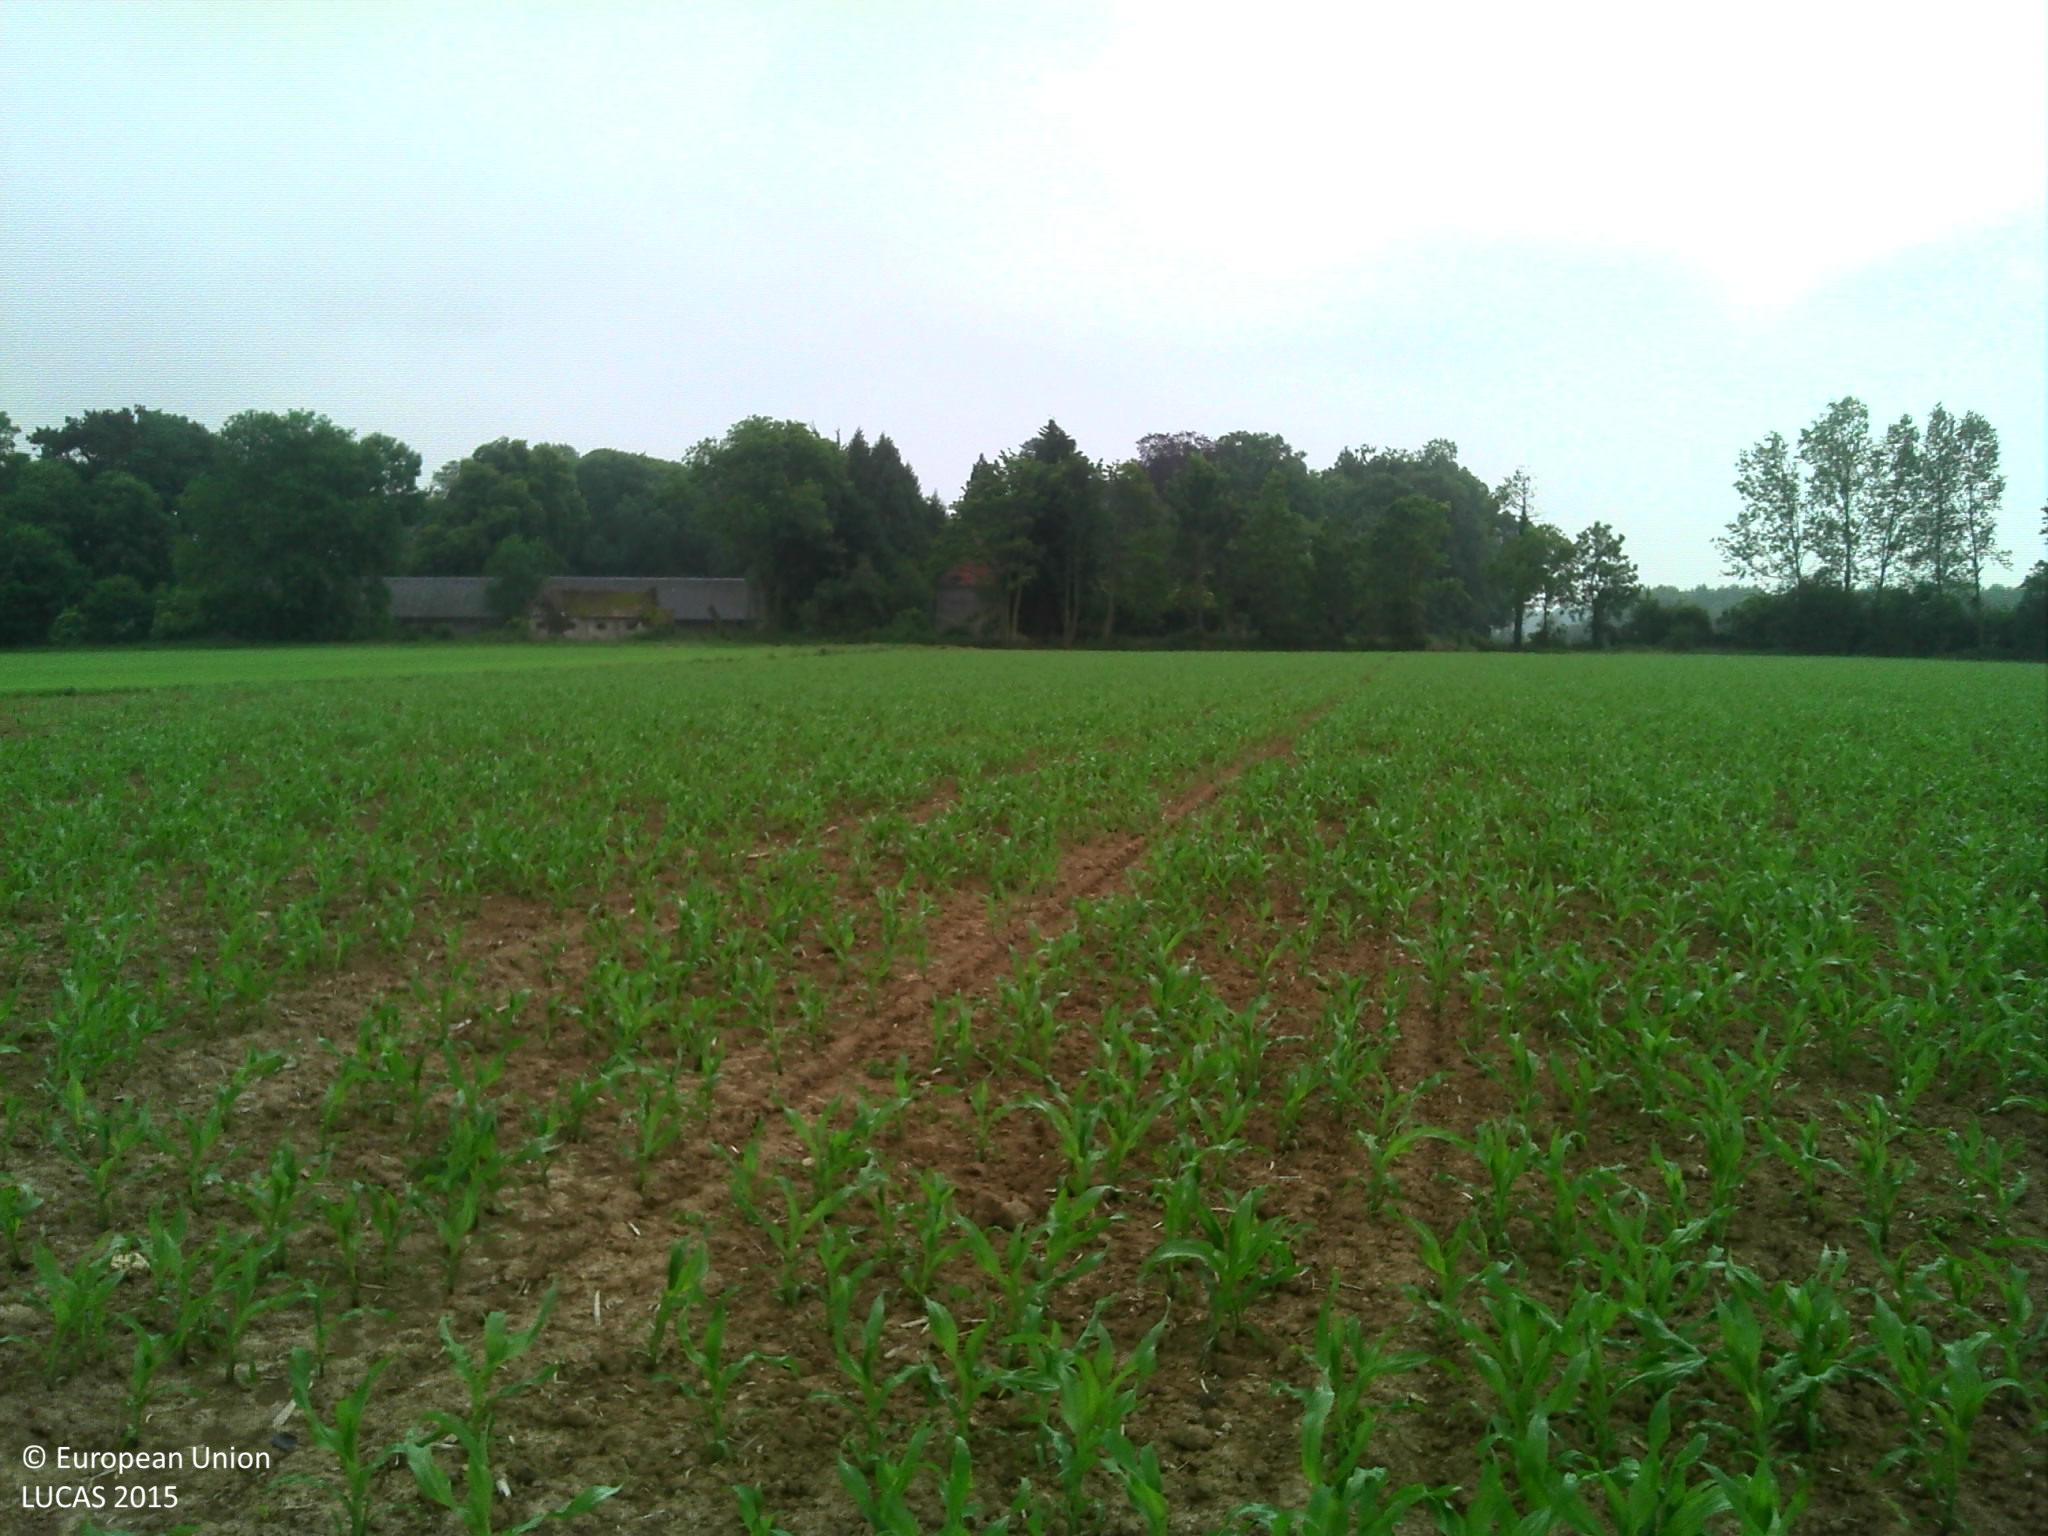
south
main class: Cropland
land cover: Maize
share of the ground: 10 - 25 %
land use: Agriculture (excluding fallow land and kitchen gardens)
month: June
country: FR
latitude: 49.2702
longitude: -0.0230
